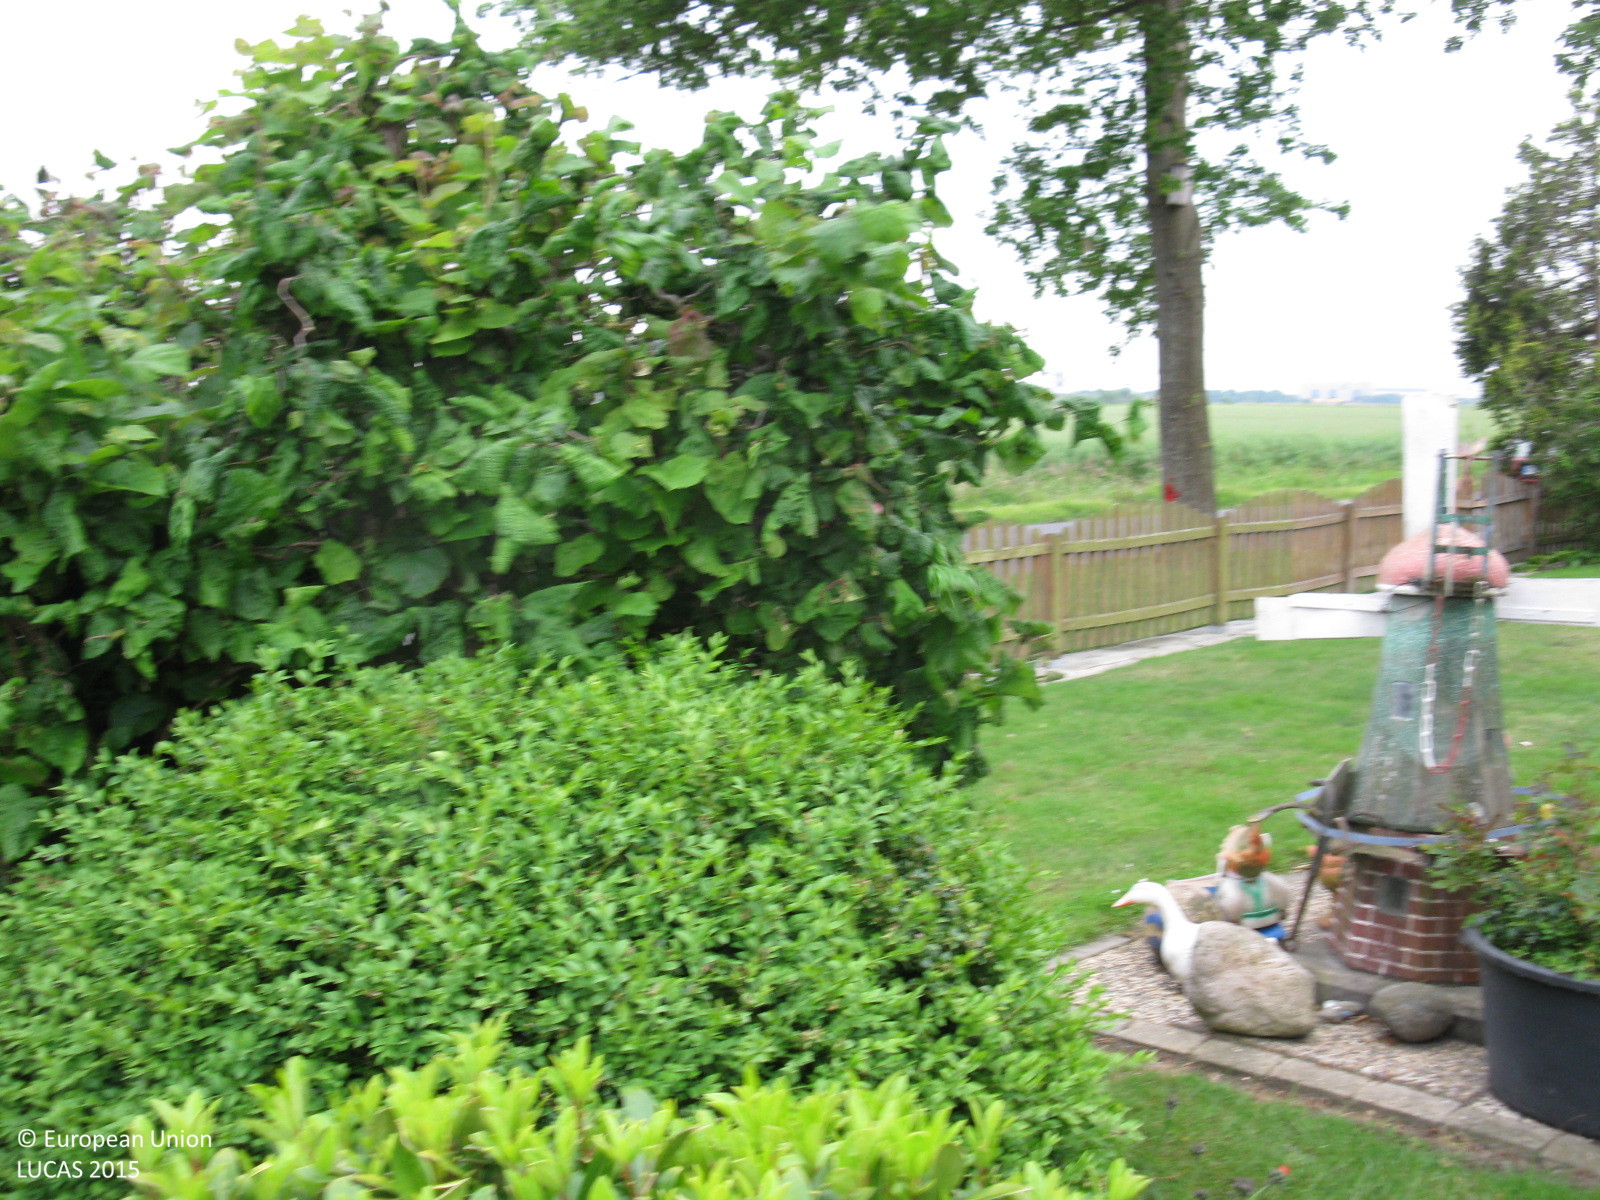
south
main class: Grassland
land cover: Grassland without tree/shrub cover
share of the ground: > 75 %
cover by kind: herbaceous plants 100 %
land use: Residential
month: June
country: DE
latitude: 53.4798
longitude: 7.3034
